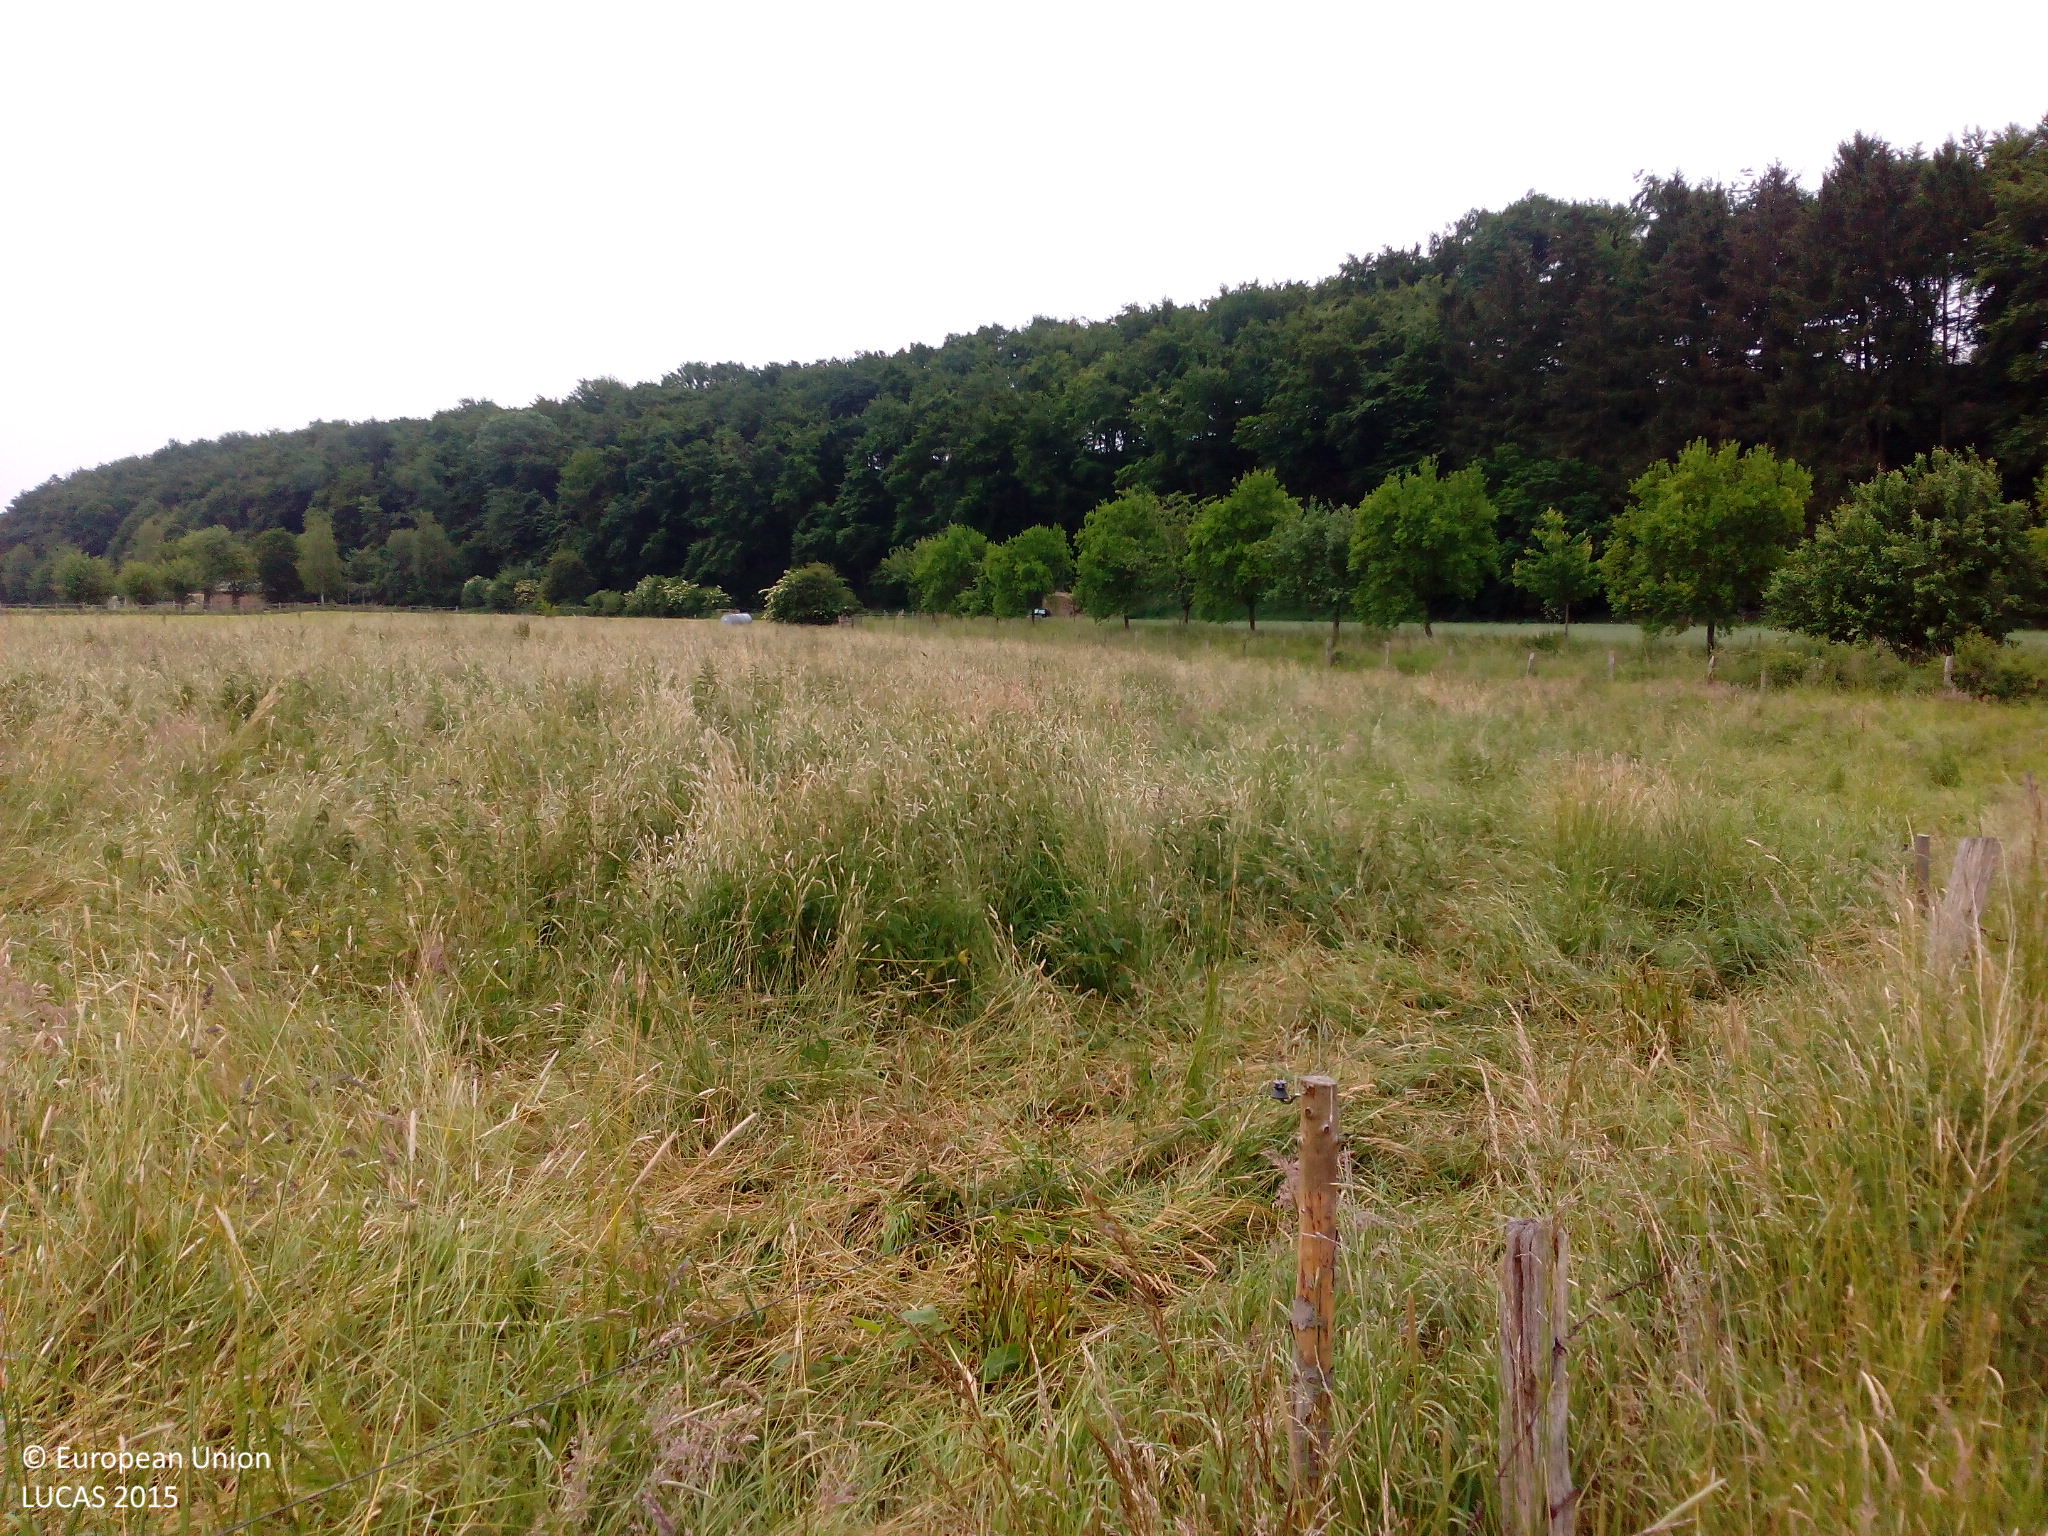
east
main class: Grassland
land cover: Grassland without tree/shrub cover
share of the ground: > 75 %
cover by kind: herbaceous plants 100 %
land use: Agriculture (excluding fallow land and kitchen gardens)
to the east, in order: Grassland without tree/shrub cover; Fences; Grassland without tree/shrub cover; Shruby margins; Ditches and canals; Shruby margins; Grass margins; Paved roads, cycling and walking lanes; Grass margins; Broadleaved woodland; Grass margins; Tracks; Grassland without tree/shrub cover
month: June
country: DE
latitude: 51.5779
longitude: 8.5718
